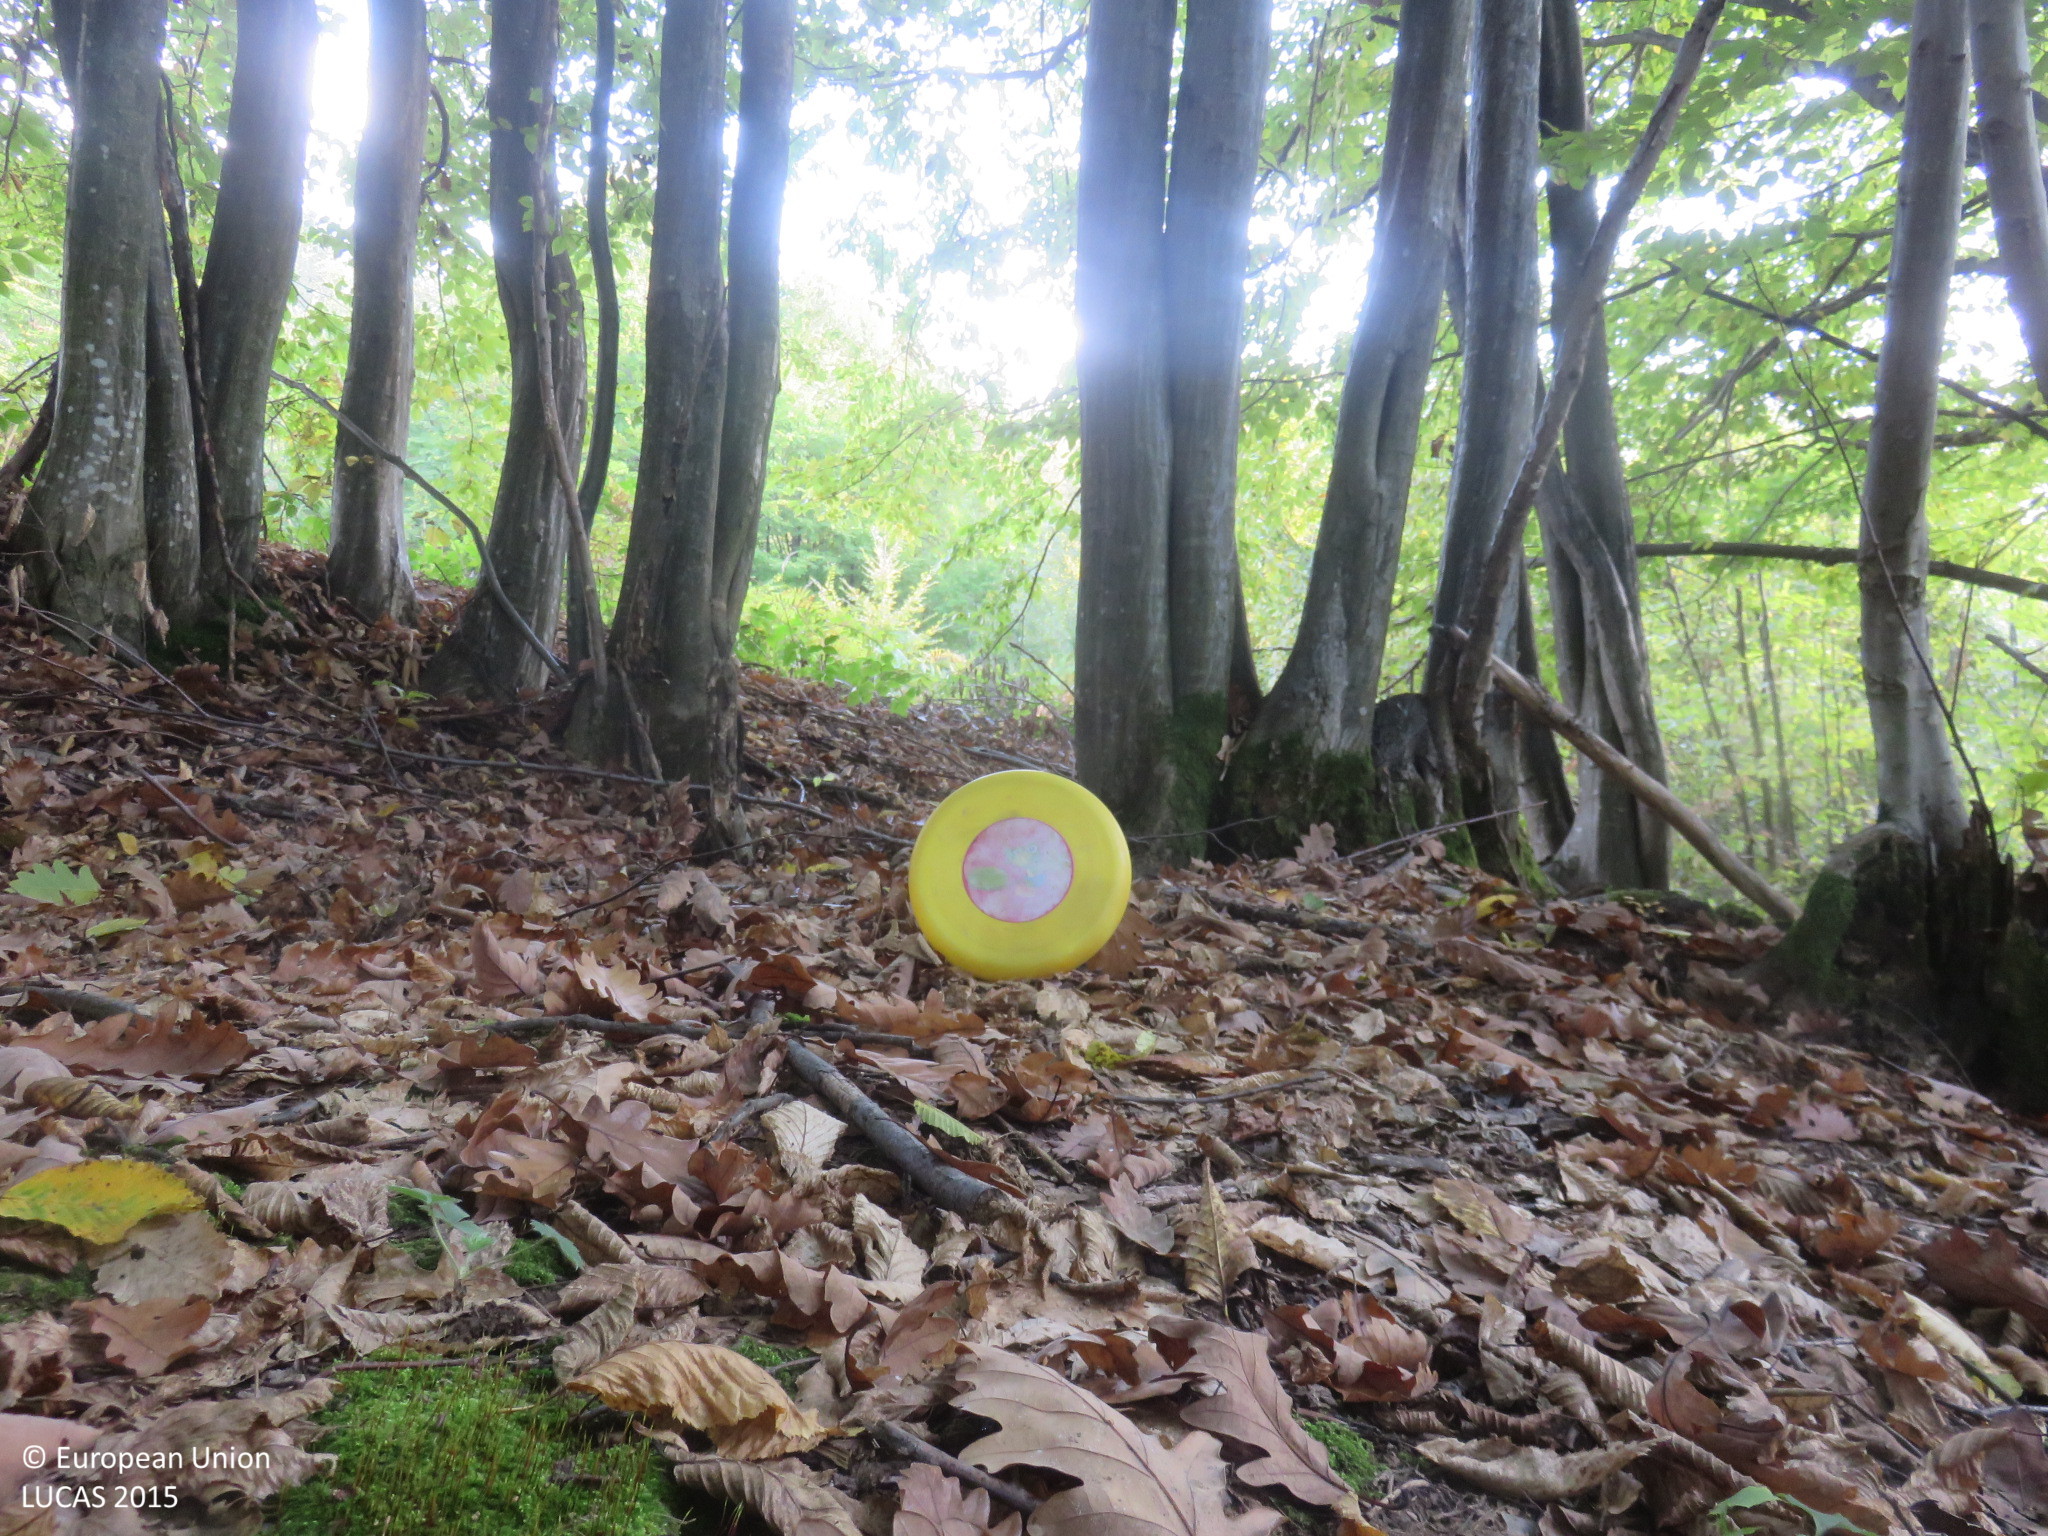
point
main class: Woodland
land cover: Broadleaved woodland
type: beech forest
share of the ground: > 75 %
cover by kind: broadleaved forest trees 95 %, shrubs 5 %
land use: Forestry
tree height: > 5 m
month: October
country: BG
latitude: 42.8384
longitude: 24.9528
